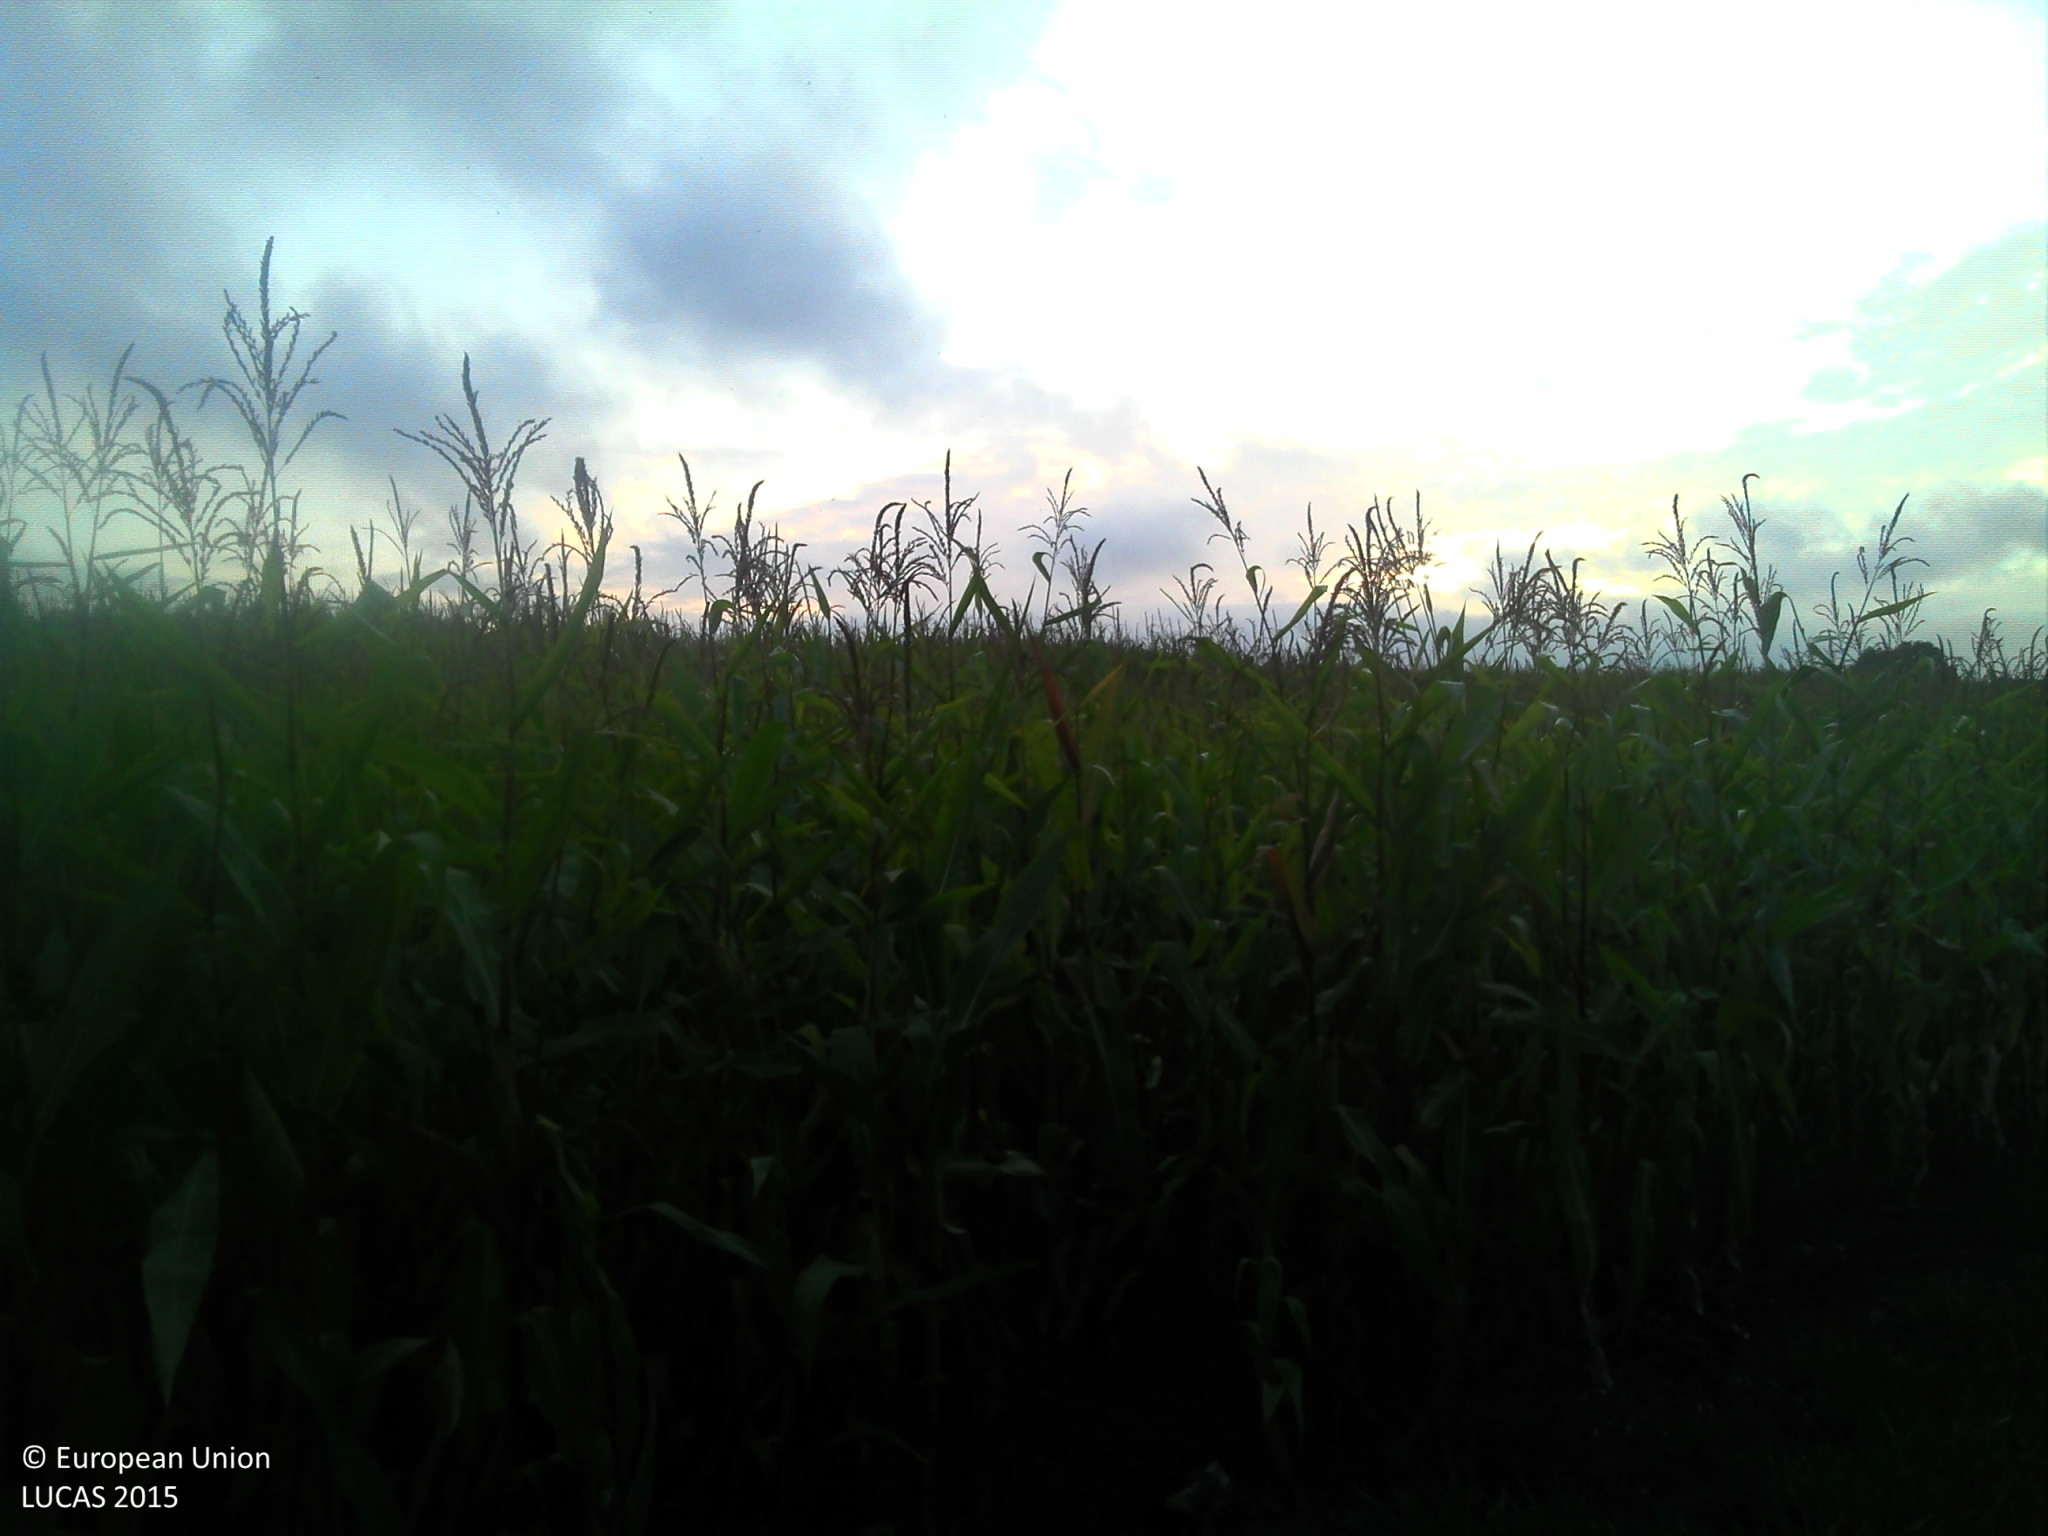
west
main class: Cropland
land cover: Maize
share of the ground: > 75 %
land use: Agriculture (excluding fallow land and kitchen gardens)
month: August
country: FR
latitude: 48.4642
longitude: 0.4948
